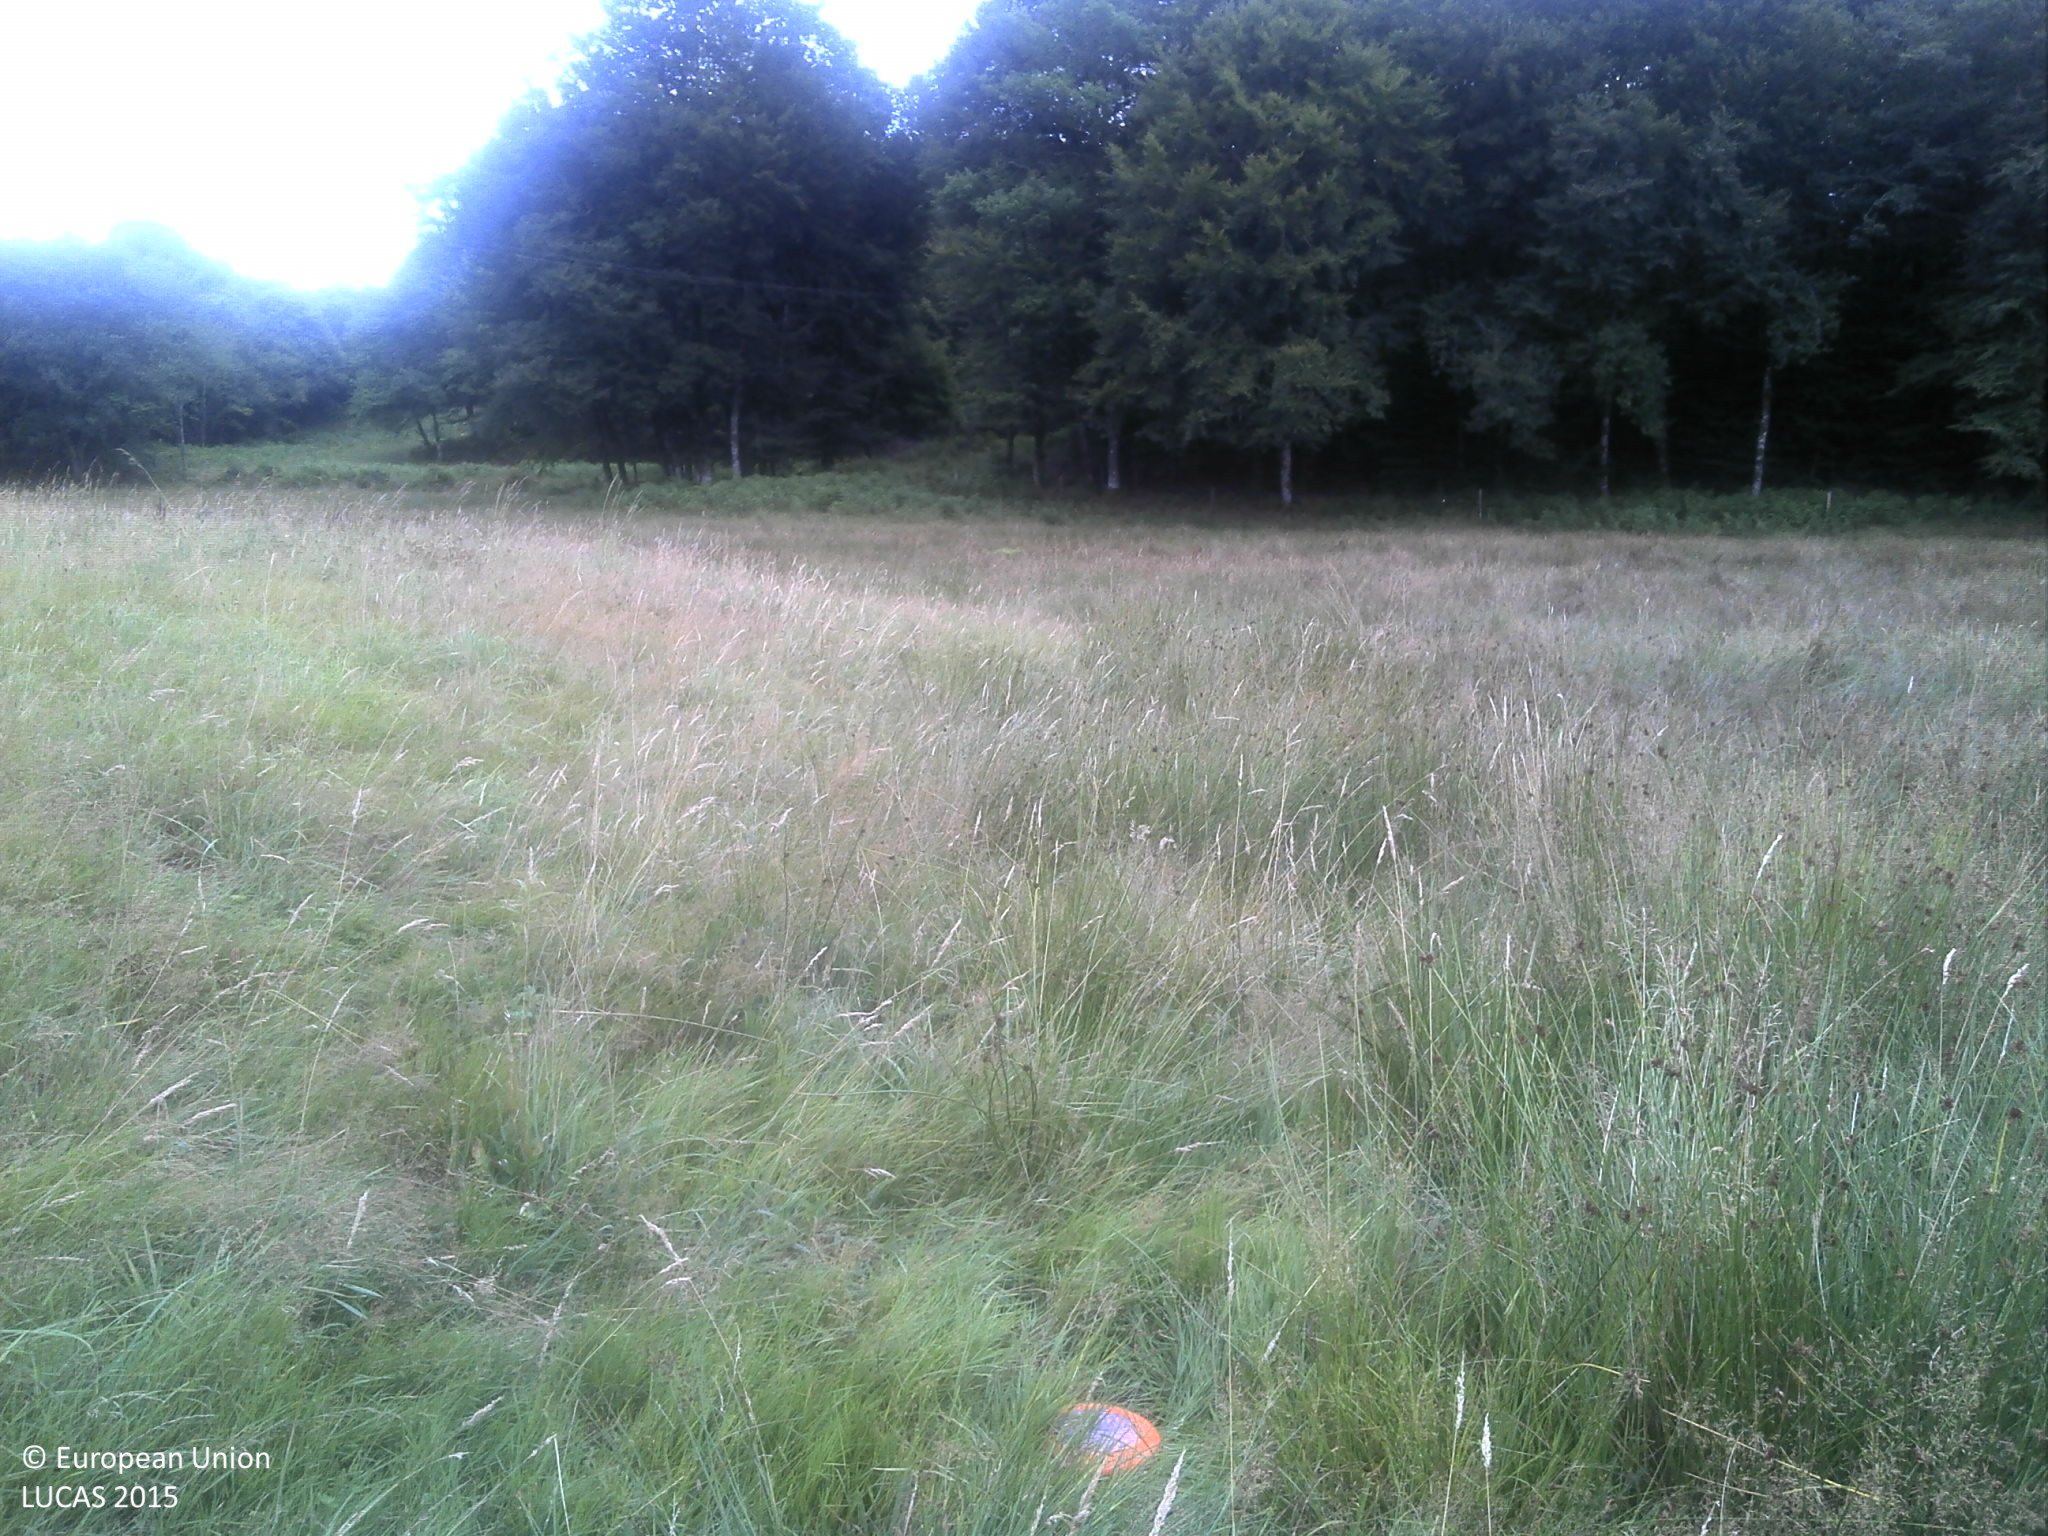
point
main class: Grassland
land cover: Grassland without tree/shrub cover
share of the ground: > 75 %
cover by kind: herbaceous plants 100 %
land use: Agriculture (excluding fallow land and kitchen gardens)
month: July
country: FR
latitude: 45.2118
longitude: 1.9117
